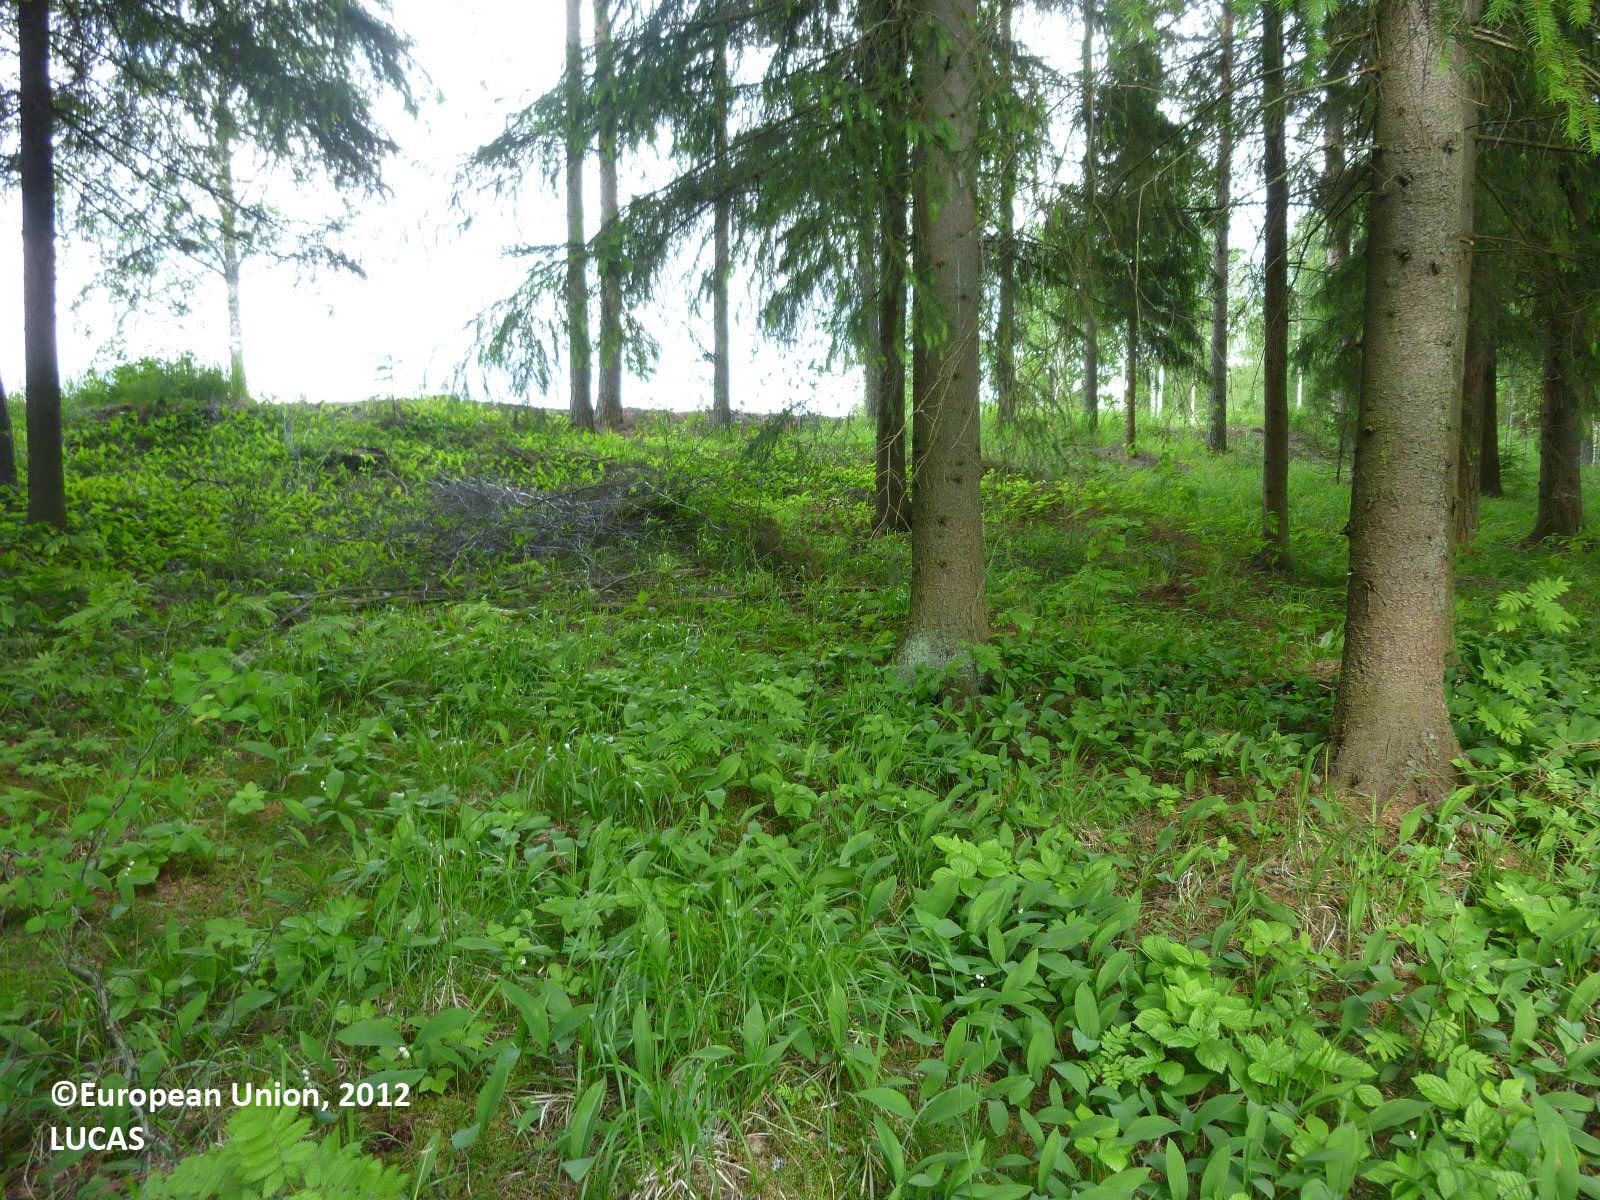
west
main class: Woodland
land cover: Spruce dominated coniferous woodland
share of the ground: > 75 %
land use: Forestry
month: June
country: FI
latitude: 61.3977
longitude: 22.6688
